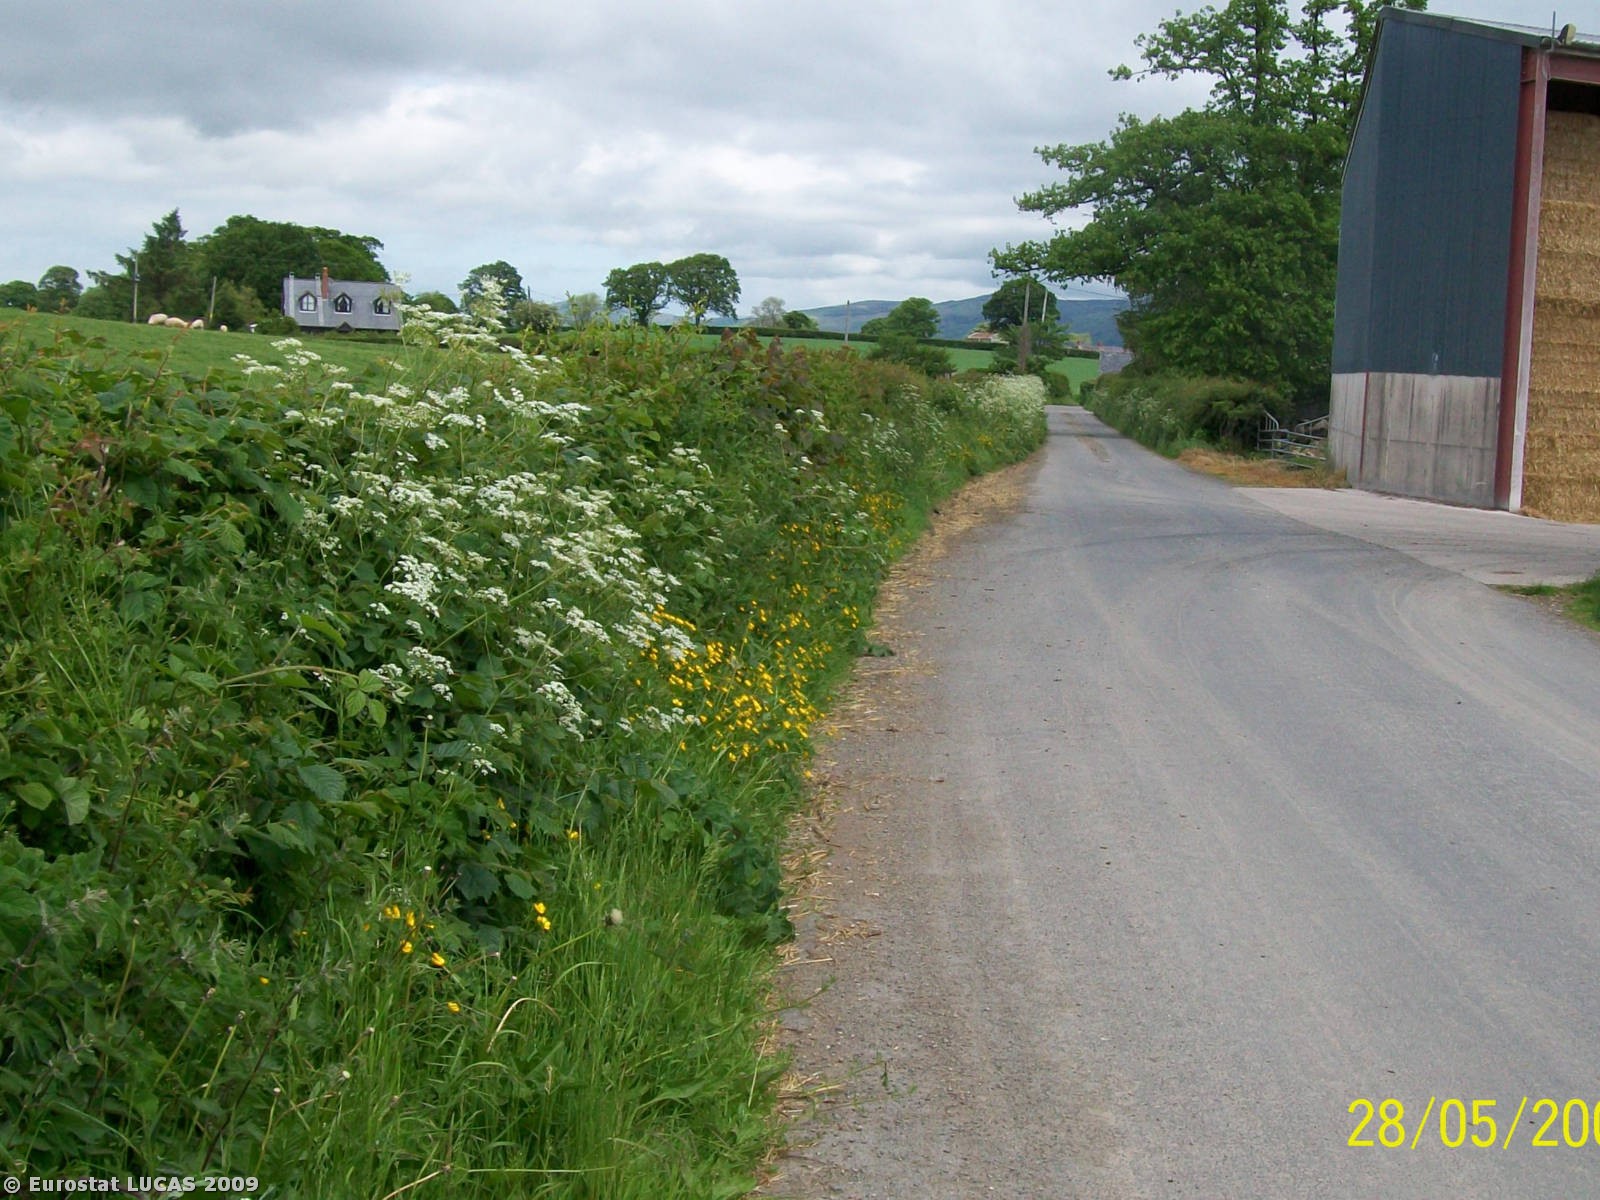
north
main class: Grassland
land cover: Grassland without tree/shrub cover
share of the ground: > 75 %
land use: Agriculture (excluding fallow land and kitchen gardens)
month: May
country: GB
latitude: 53.0666
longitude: -3.2873
